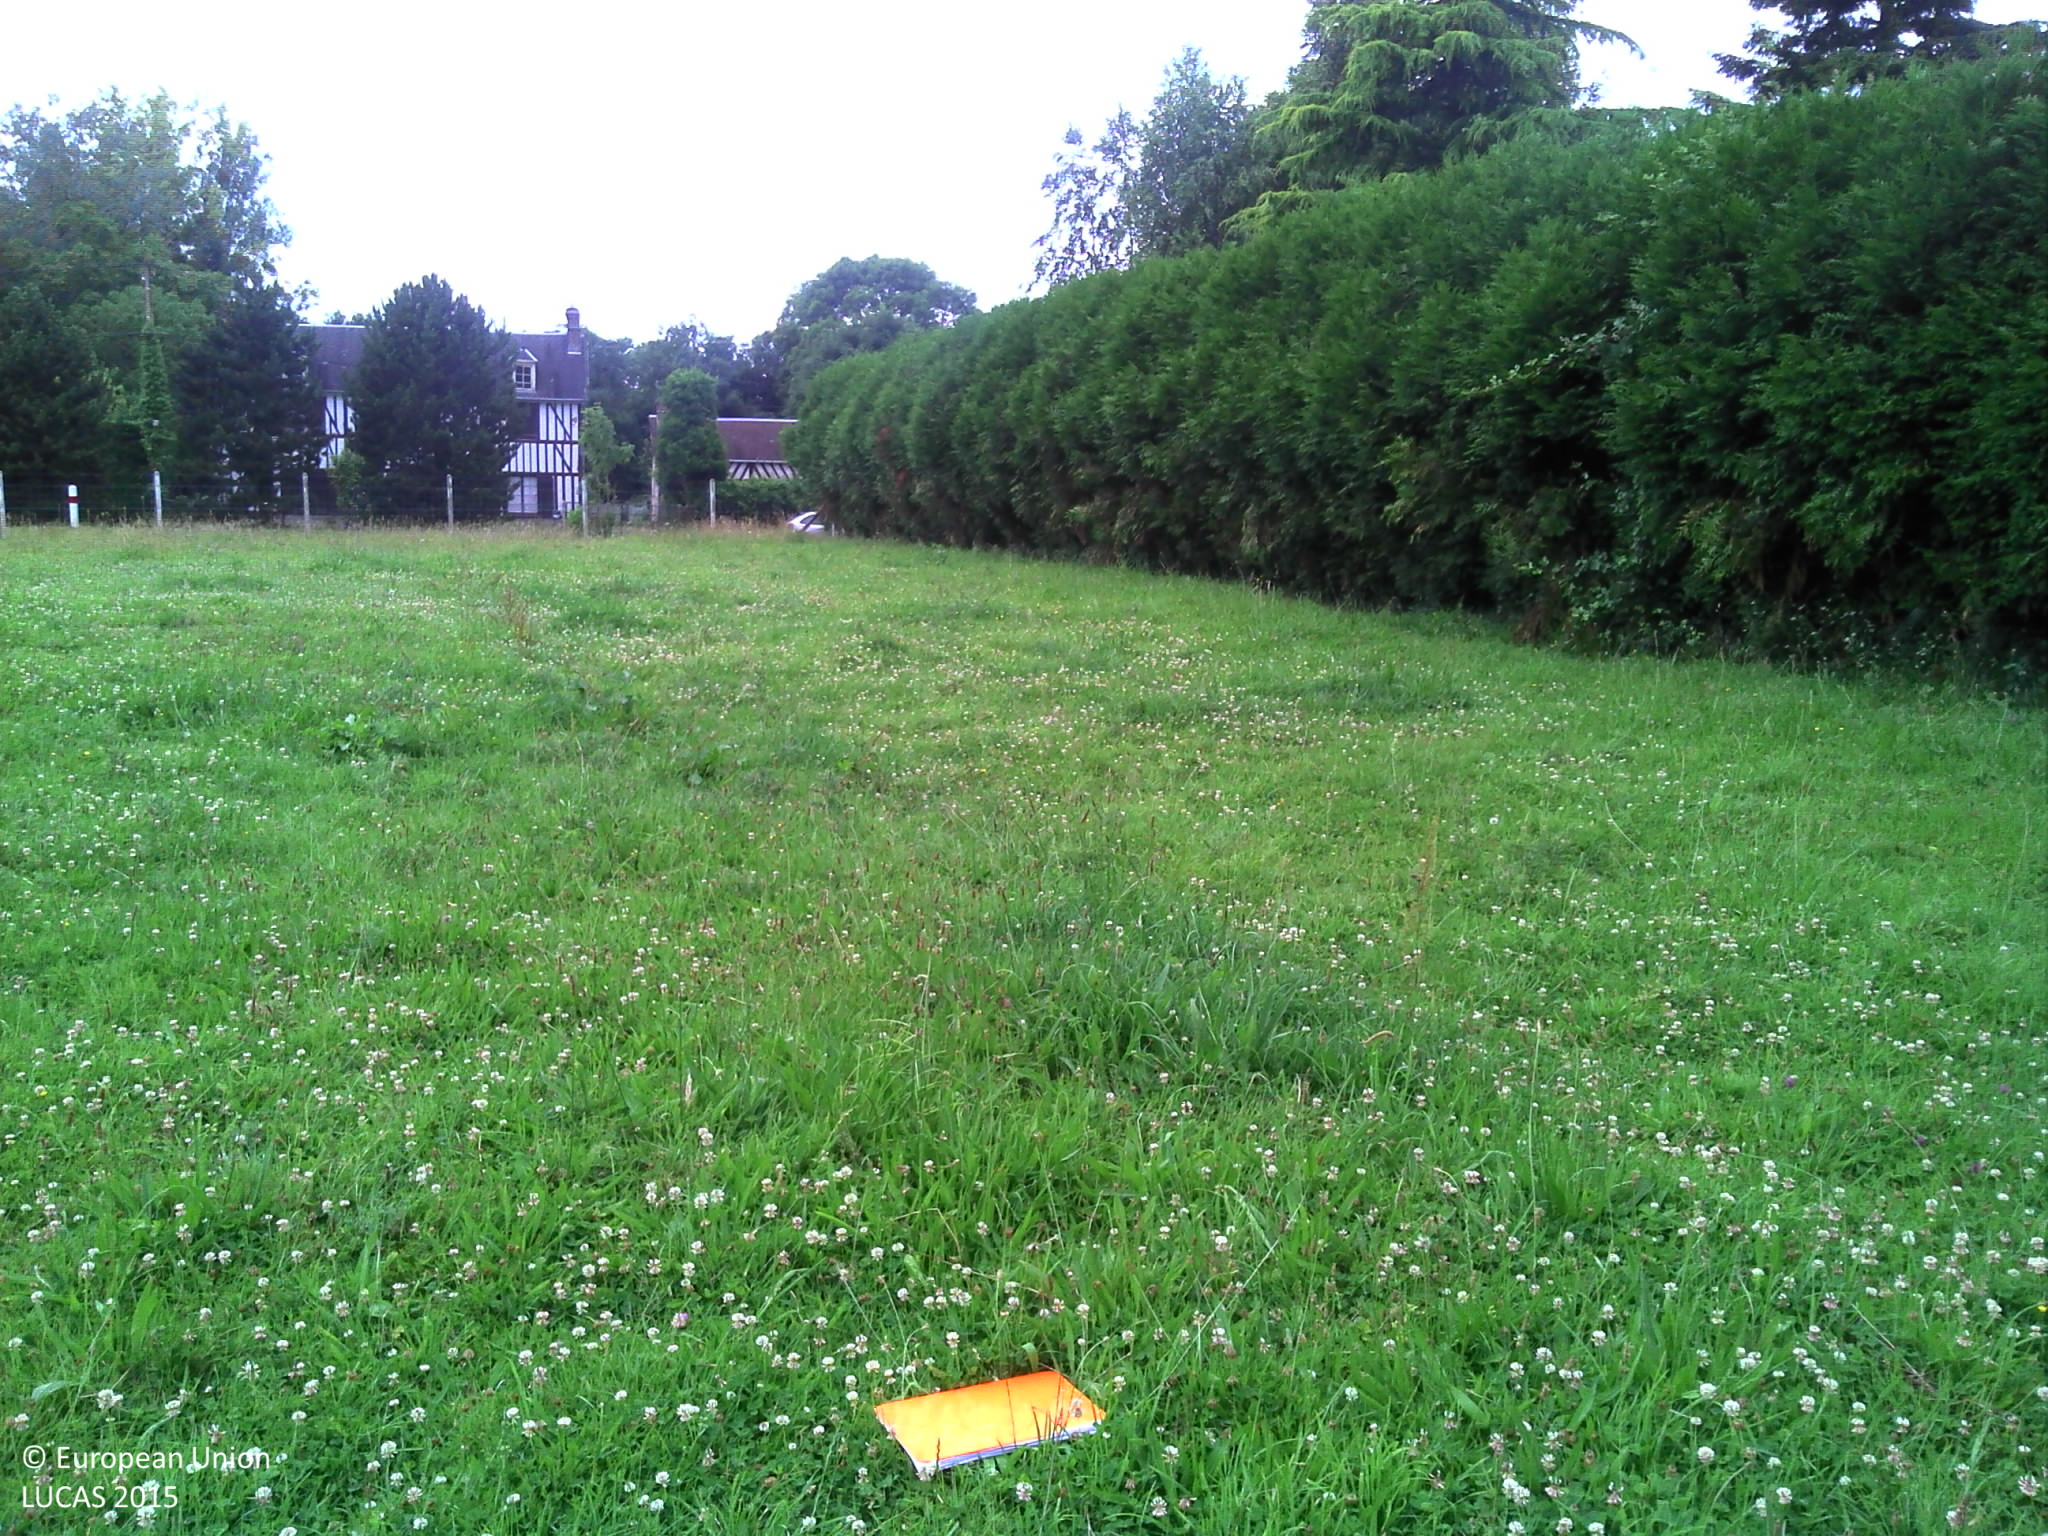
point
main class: Grassland
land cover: Grassland without tree/shrub cover
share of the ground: > 75 %
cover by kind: herbaceous plants 100 %
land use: Agriculture (excluding fallow land and kitchen gardens)
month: July
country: FR
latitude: 49.3727
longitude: 0.3175
